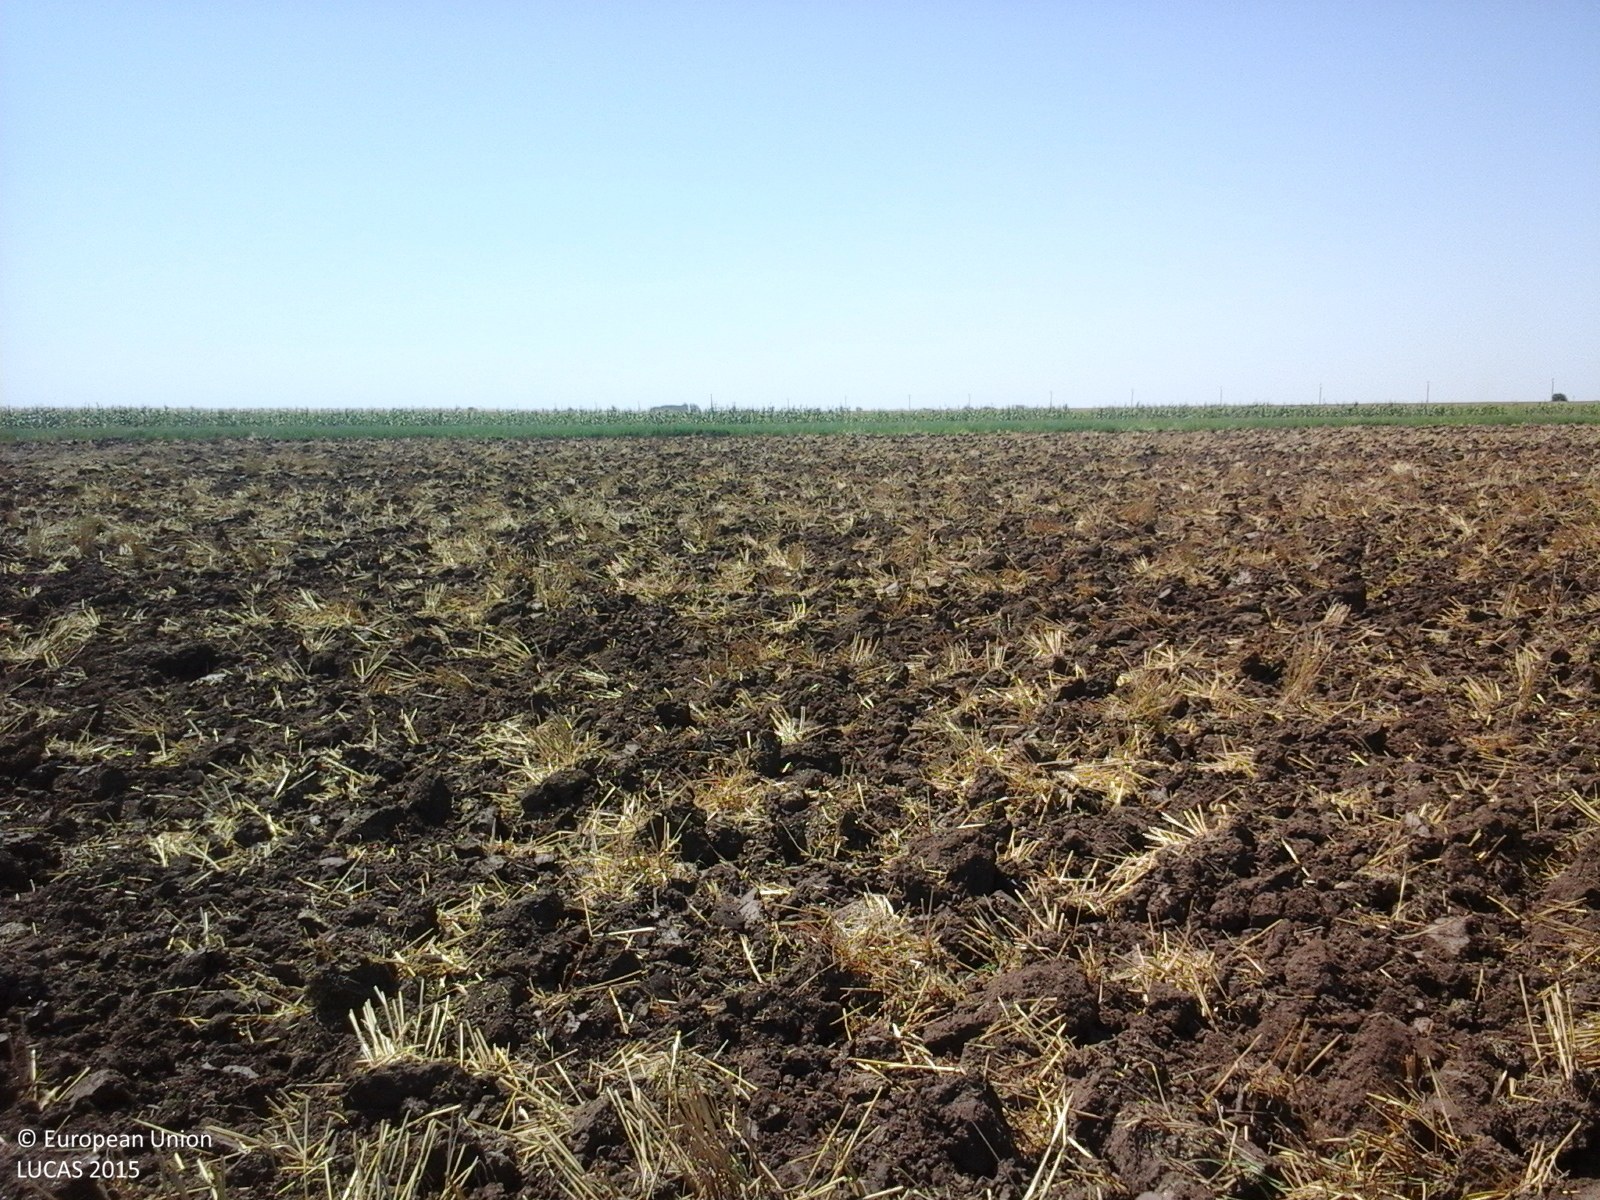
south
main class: Cropland
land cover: Durum wheat
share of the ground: < 10 %
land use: Agriculture (excluding fallow land and kitchen gardens)
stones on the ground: < 10 %
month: July
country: RO
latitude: 44.3446
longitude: 26.4831
